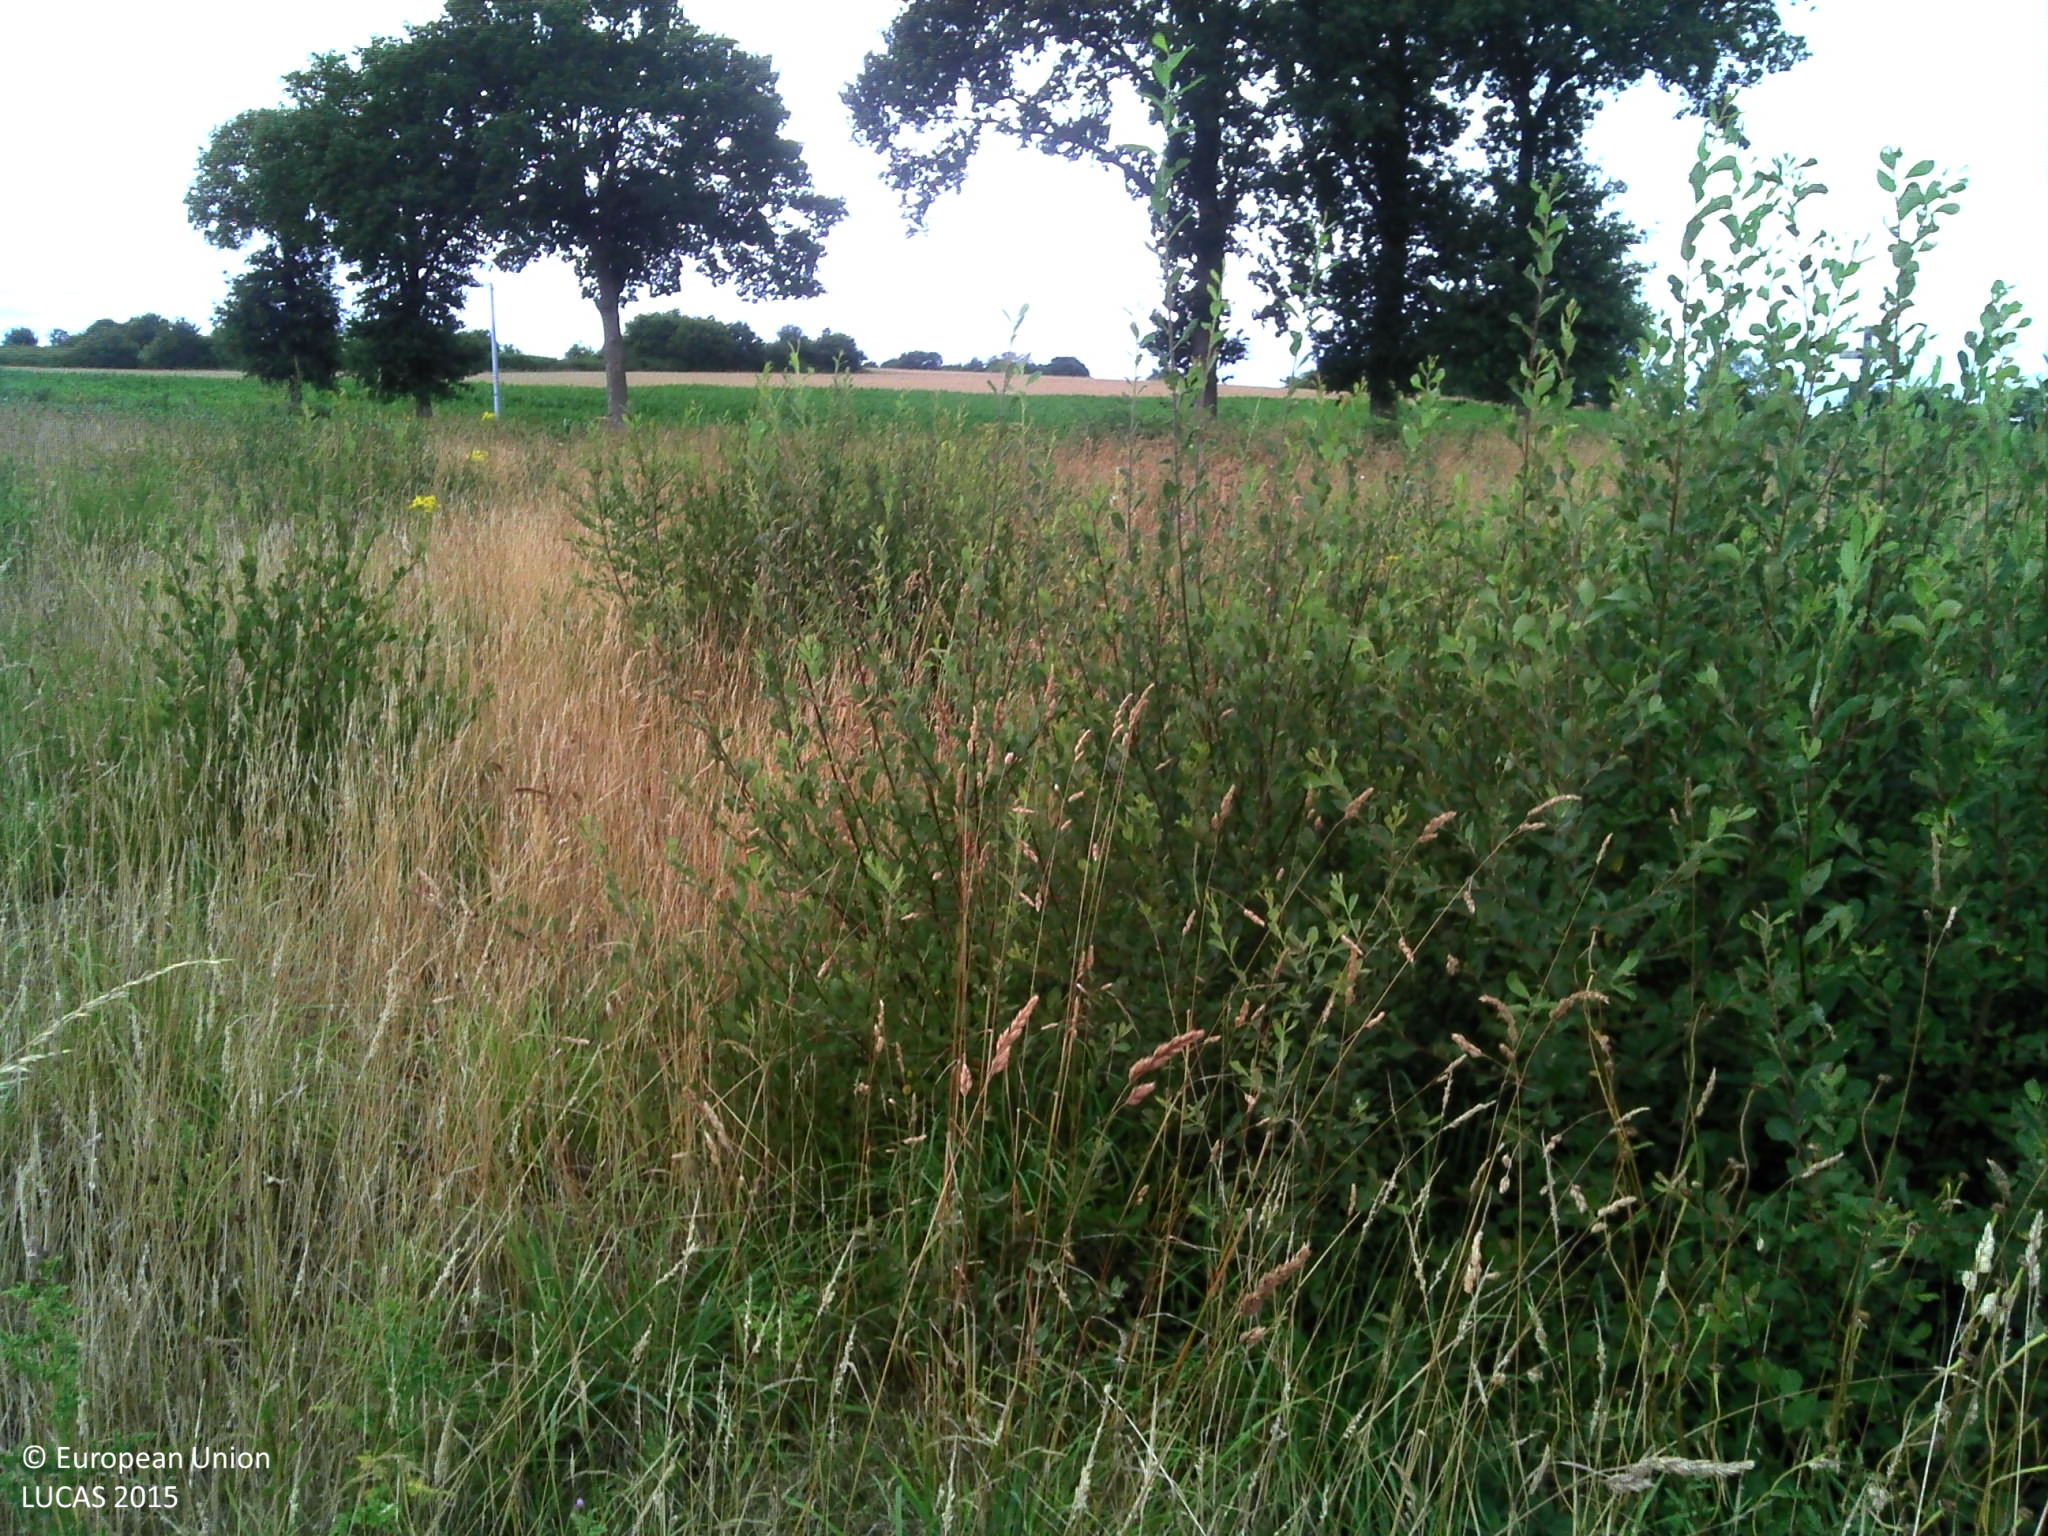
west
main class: Grassland
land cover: Grassland without tree/shrub cover
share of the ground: > 75 %
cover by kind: herbaceous plants 100 %
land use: Agriculture (excluding fallow land and kitchen gardens)
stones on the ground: 10 - 25 %
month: July
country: FR
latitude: 47.8726
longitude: -2.0177
